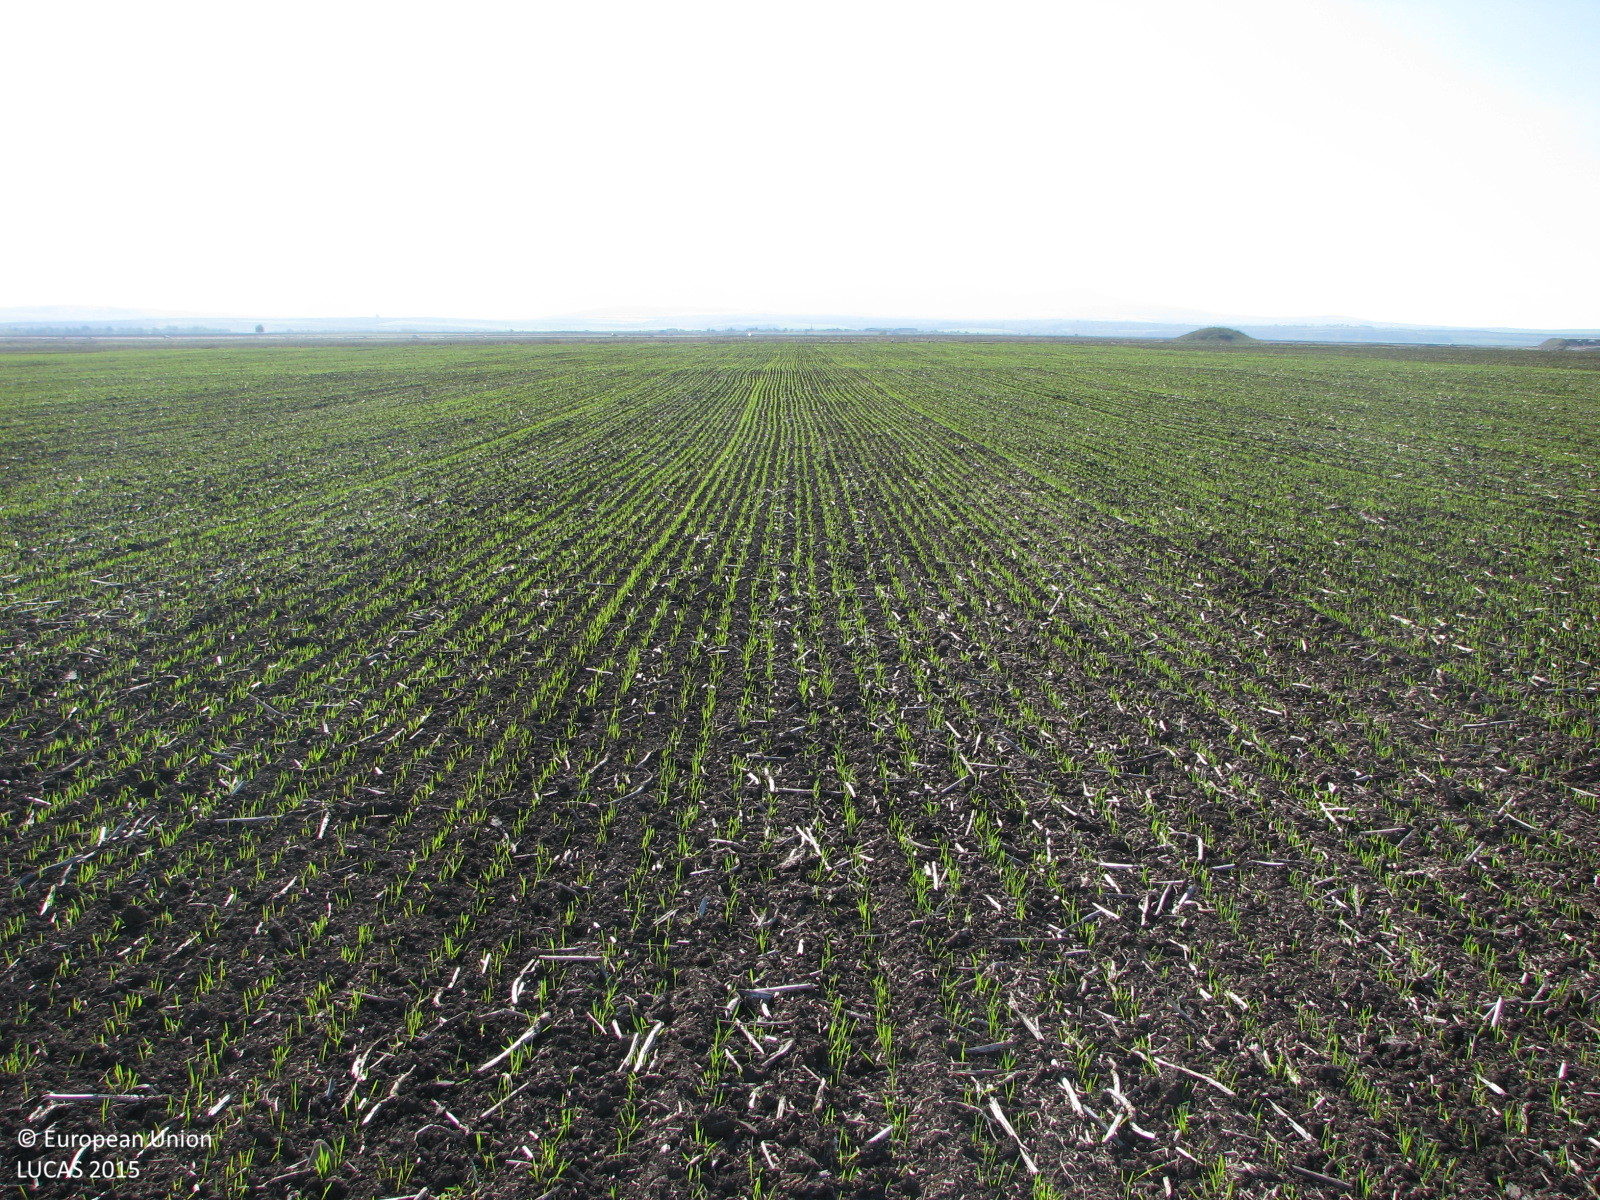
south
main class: Cropland
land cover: Common wheat
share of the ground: 10 - 25 %
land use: Agriculture (excluding fallow land and kitchen gardens)
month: November
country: BG
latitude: 42.5664
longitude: 26.6764
